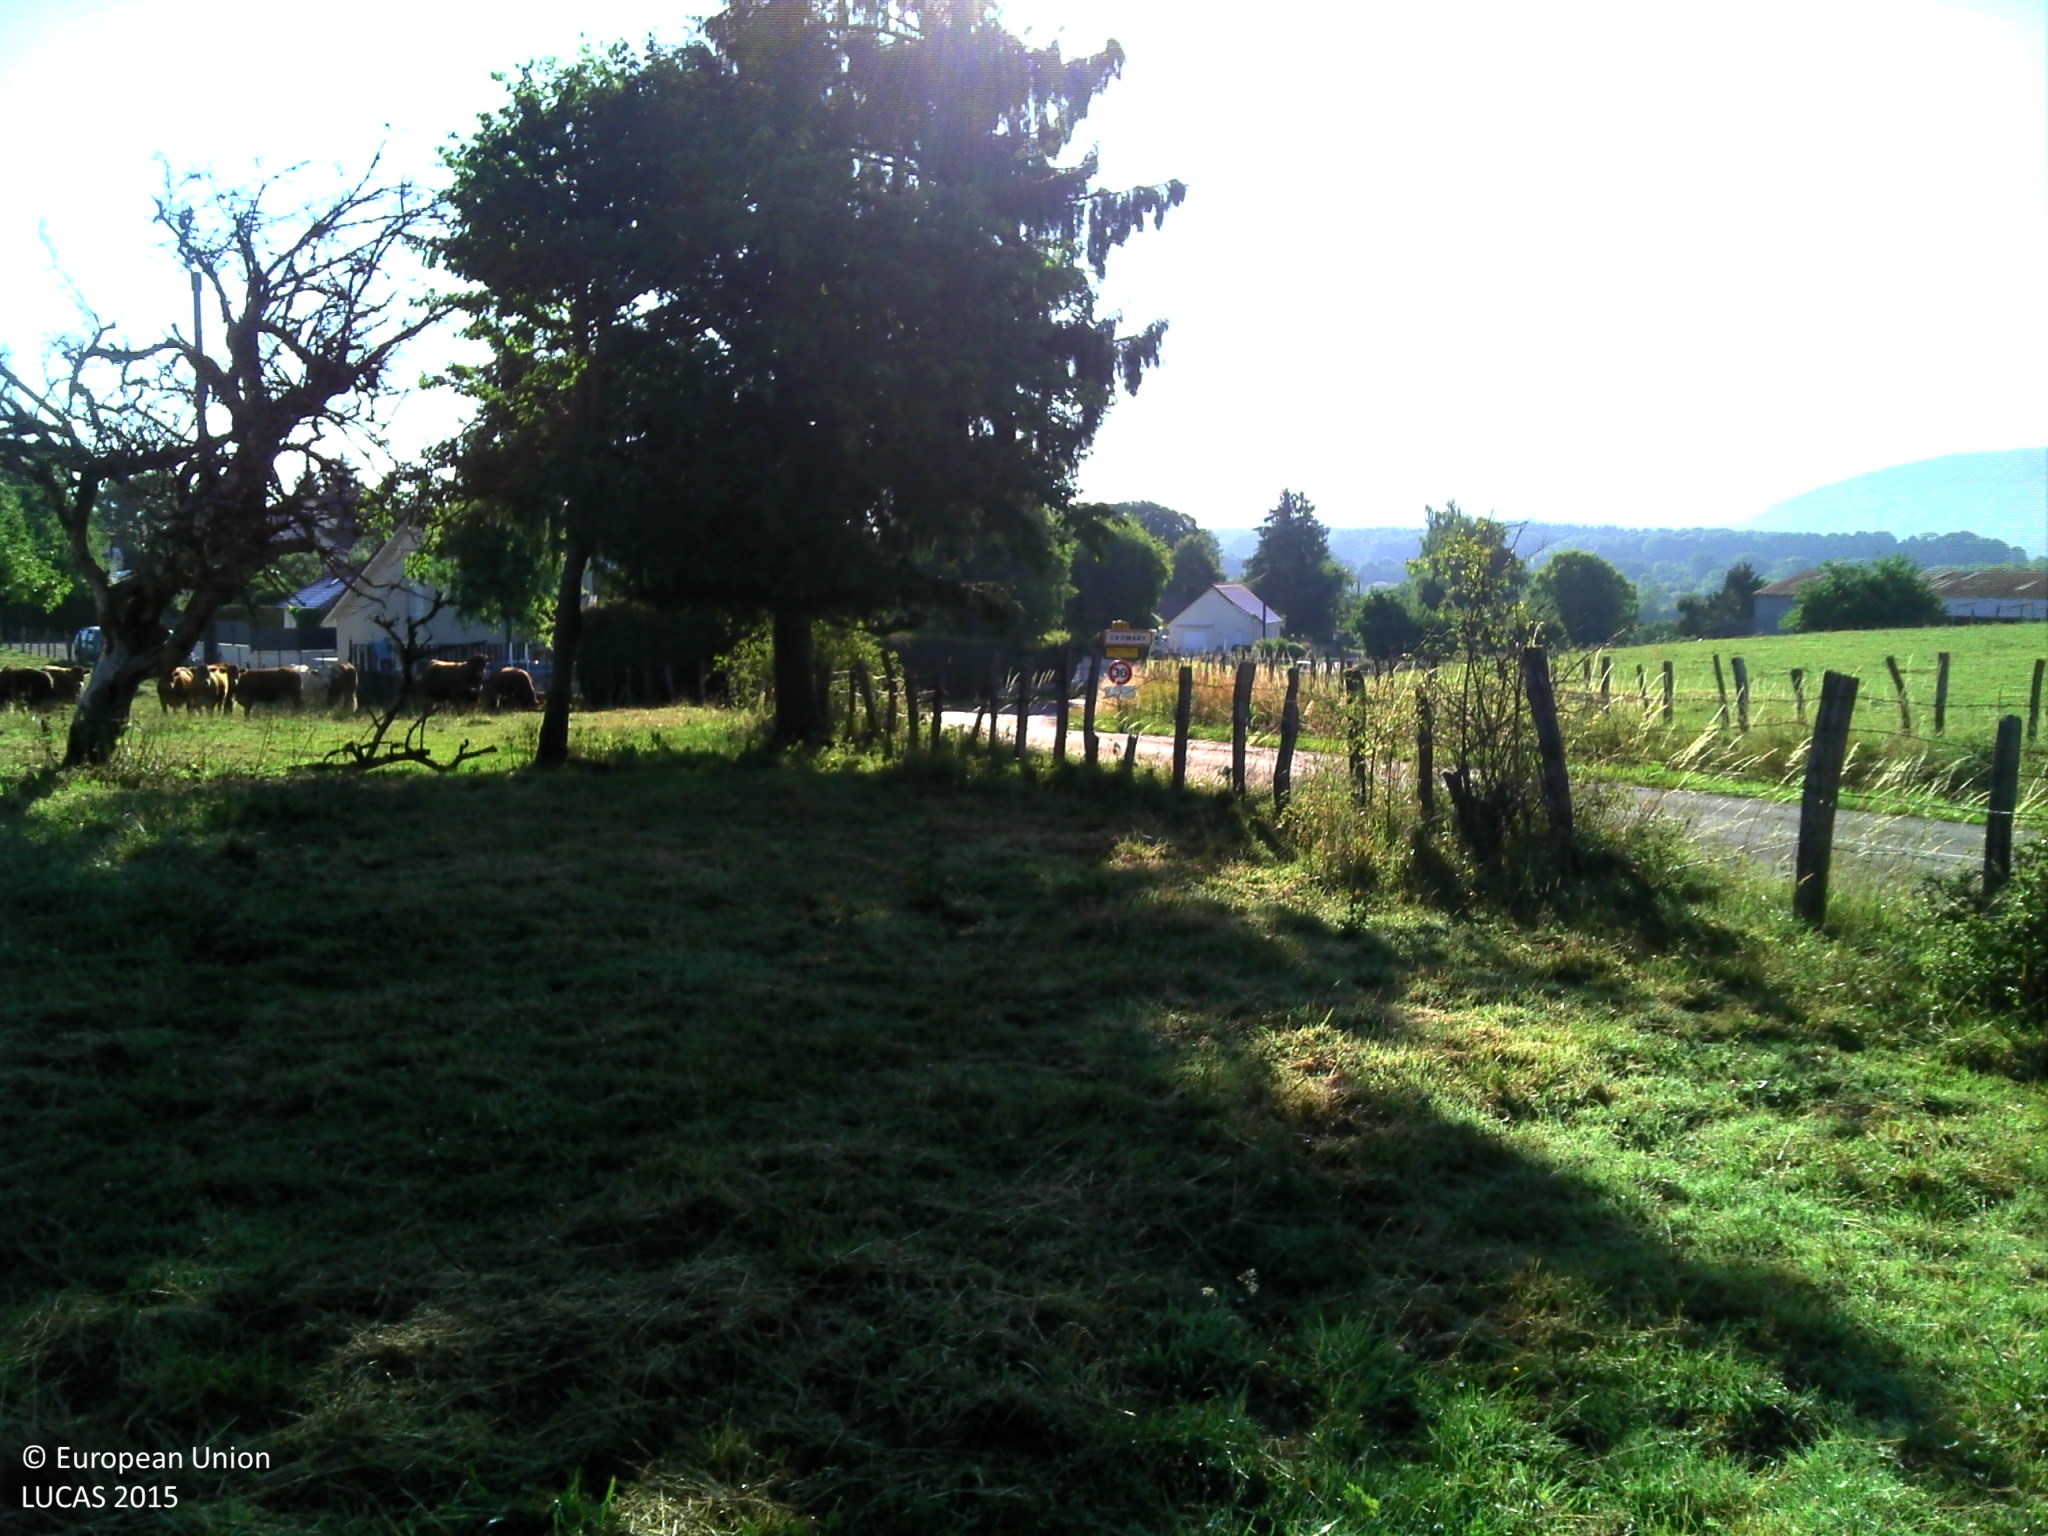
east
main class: Grassland
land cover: Grassland without tree/shrub cover
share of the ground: > 75 %
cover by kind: herbaceous plants 100 %
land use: Agriculture (excluding fallow land and kitchen gardens)
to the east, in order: Grassland without tree/shrub cover; Electric lines; Grassland without tree/shrub cover; Fences; Ditches and canals; Grass margins; Paved roads, cycling and walking lanes; Grass margins; Ditches and canals; Fences; Grassland without tree/shrub cover; Fences; Abandoned hedges; Grassland without tree/shrub cover; Abandoned hedges; Electric lines; Abandoned hedges; Fences; Grass margins; Paved roads, cycling and walking lanes
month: June
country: FR
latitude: 47.3606
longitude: 6.0692
